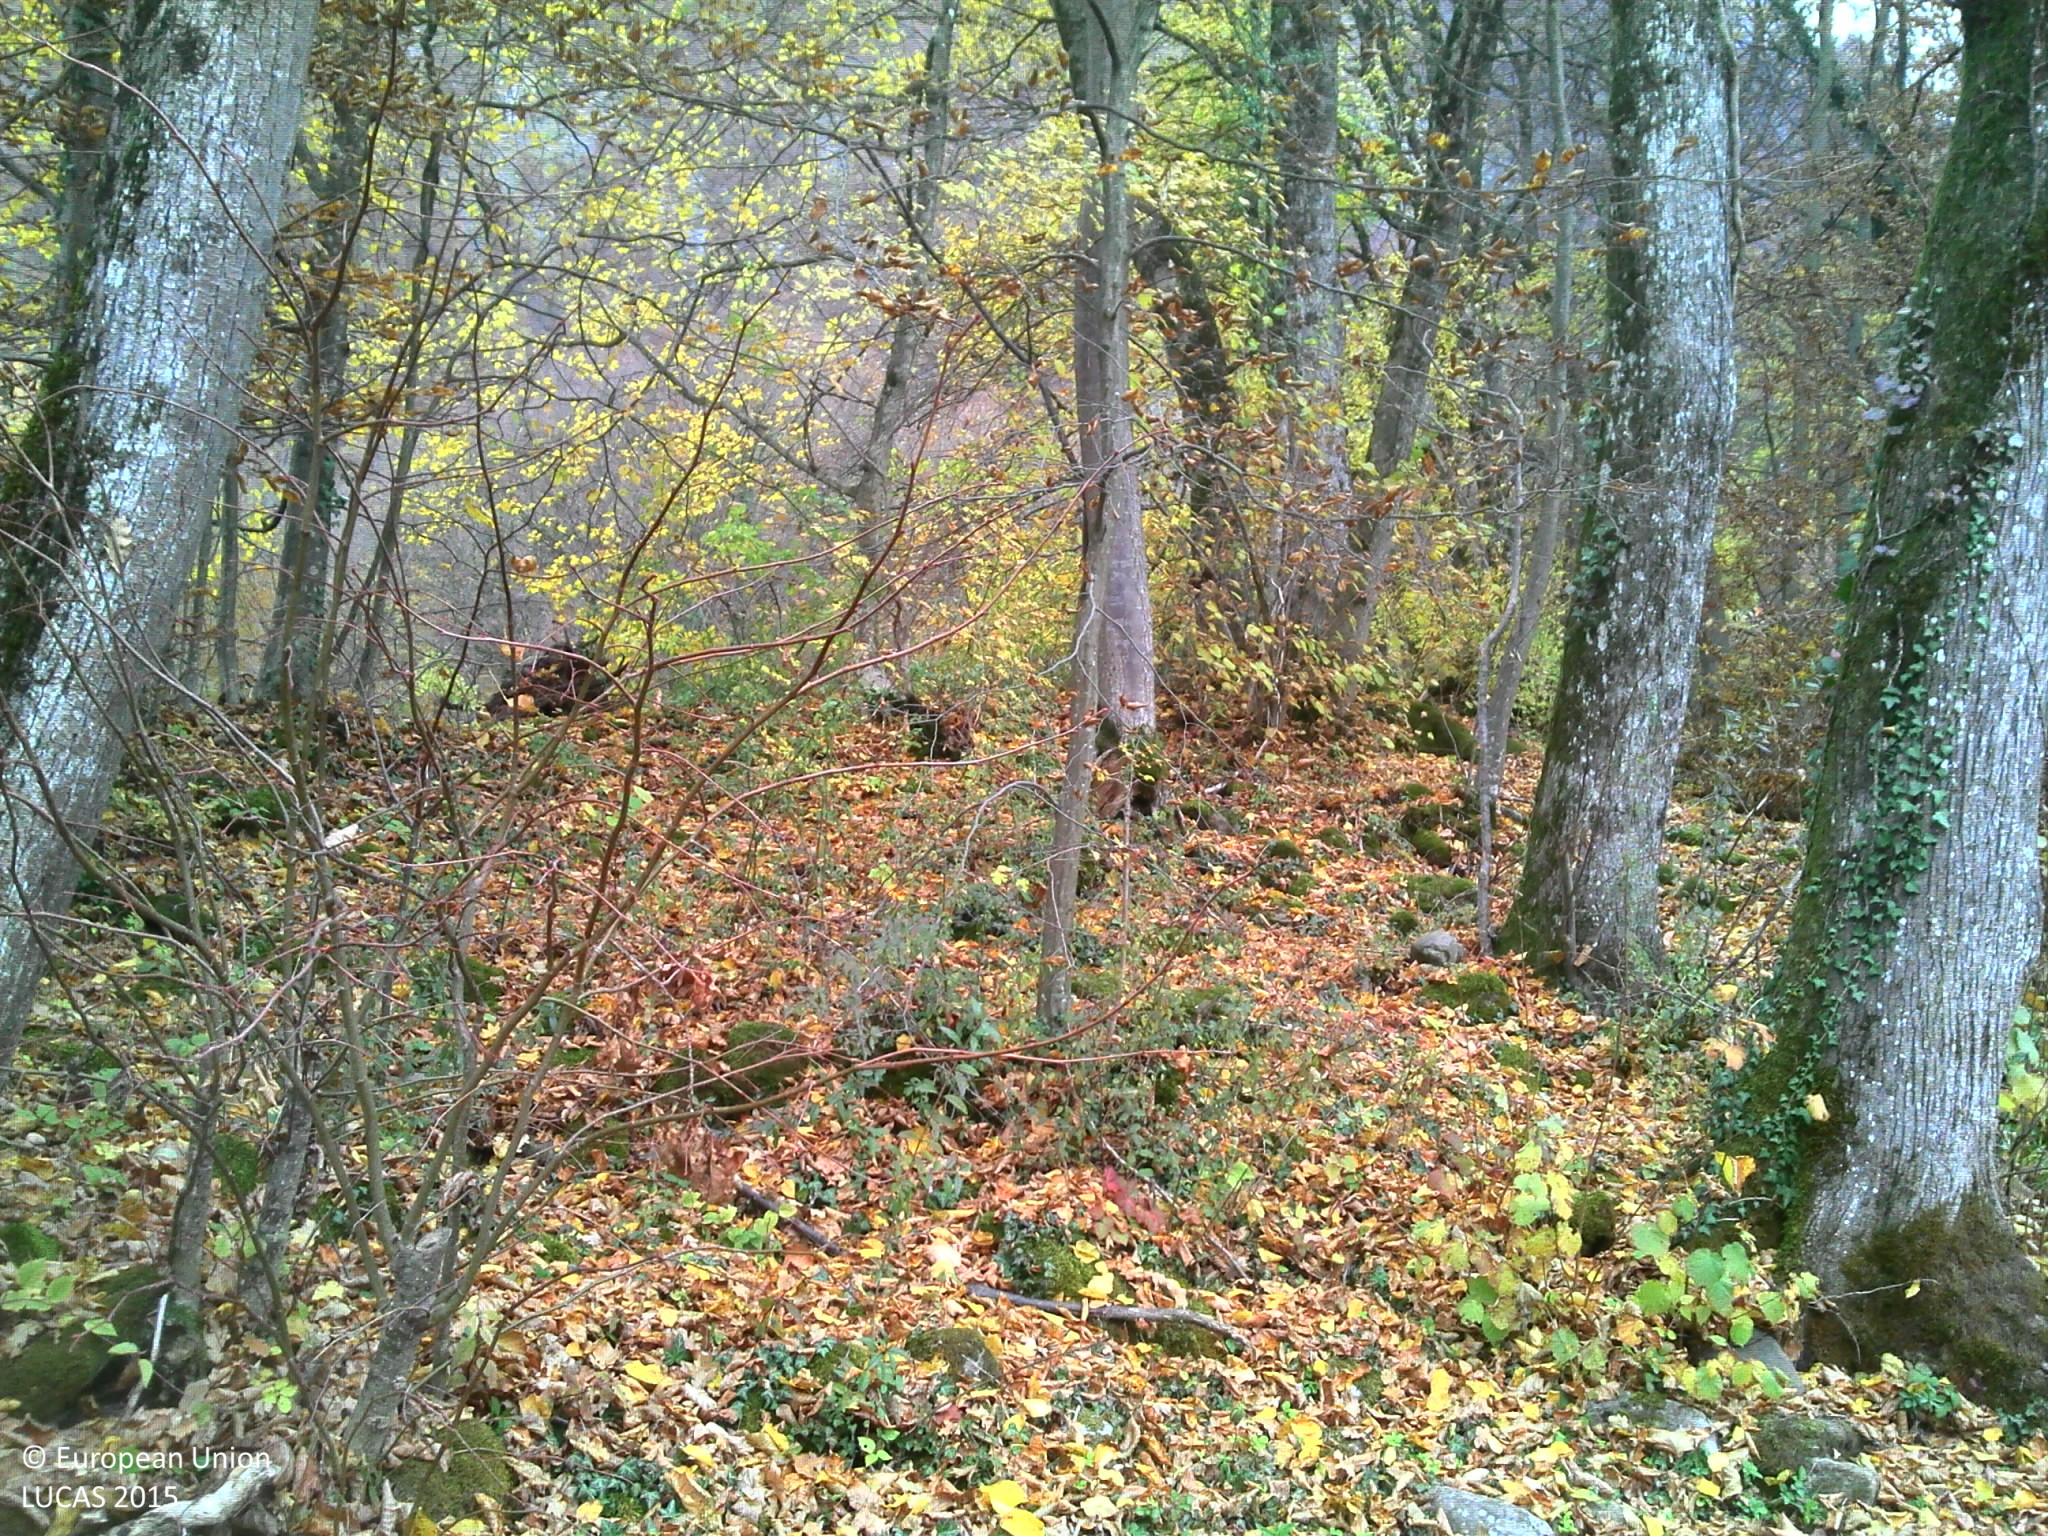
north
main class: Grassland
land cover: Grassland without tree/shrub cover
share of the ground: > 75 %
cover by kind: herbaceous plants 100 %
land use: Residential
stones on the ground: < 10 %
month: November
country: FR
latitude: 45.7674
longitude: 6.3909
